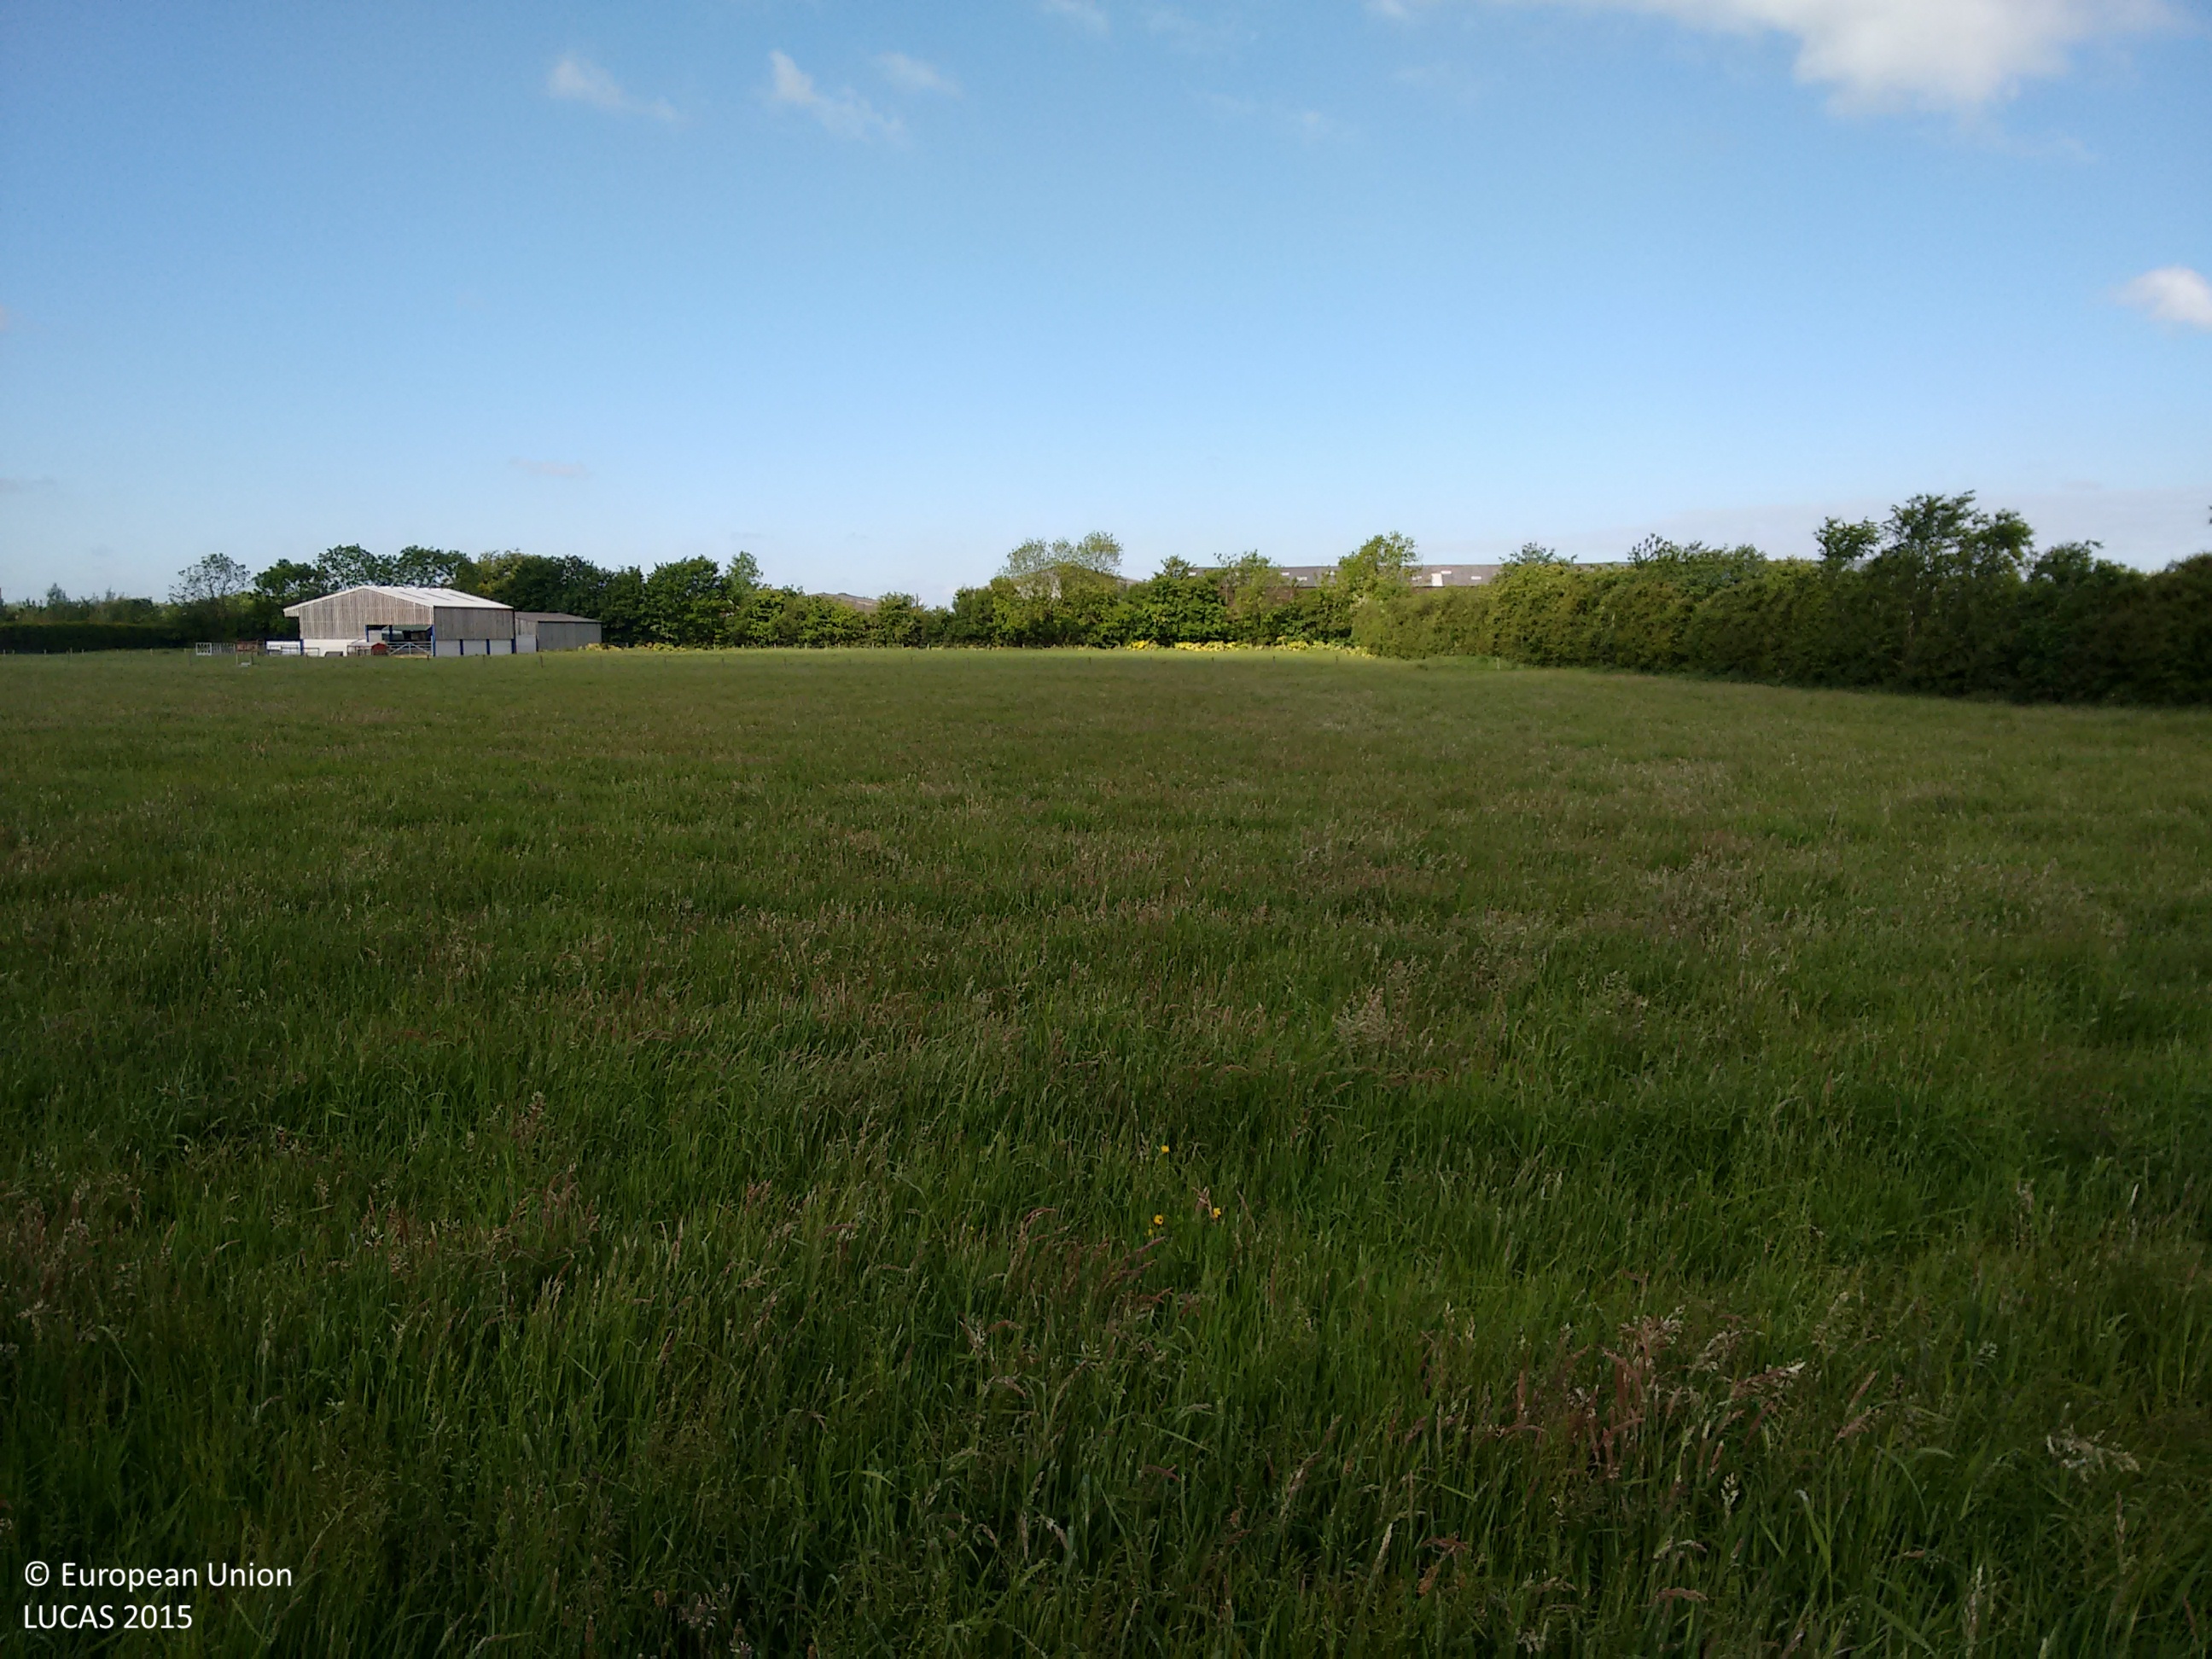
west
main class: Grassland
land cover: Grassland without tree/shrub cover
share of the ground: > 75 %
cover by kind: herbaceous plants 100 %
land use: Agriculture (excluding fallow land and kitchen gardens)
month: June
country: GB
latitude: 54.0802
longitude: -1.1878
